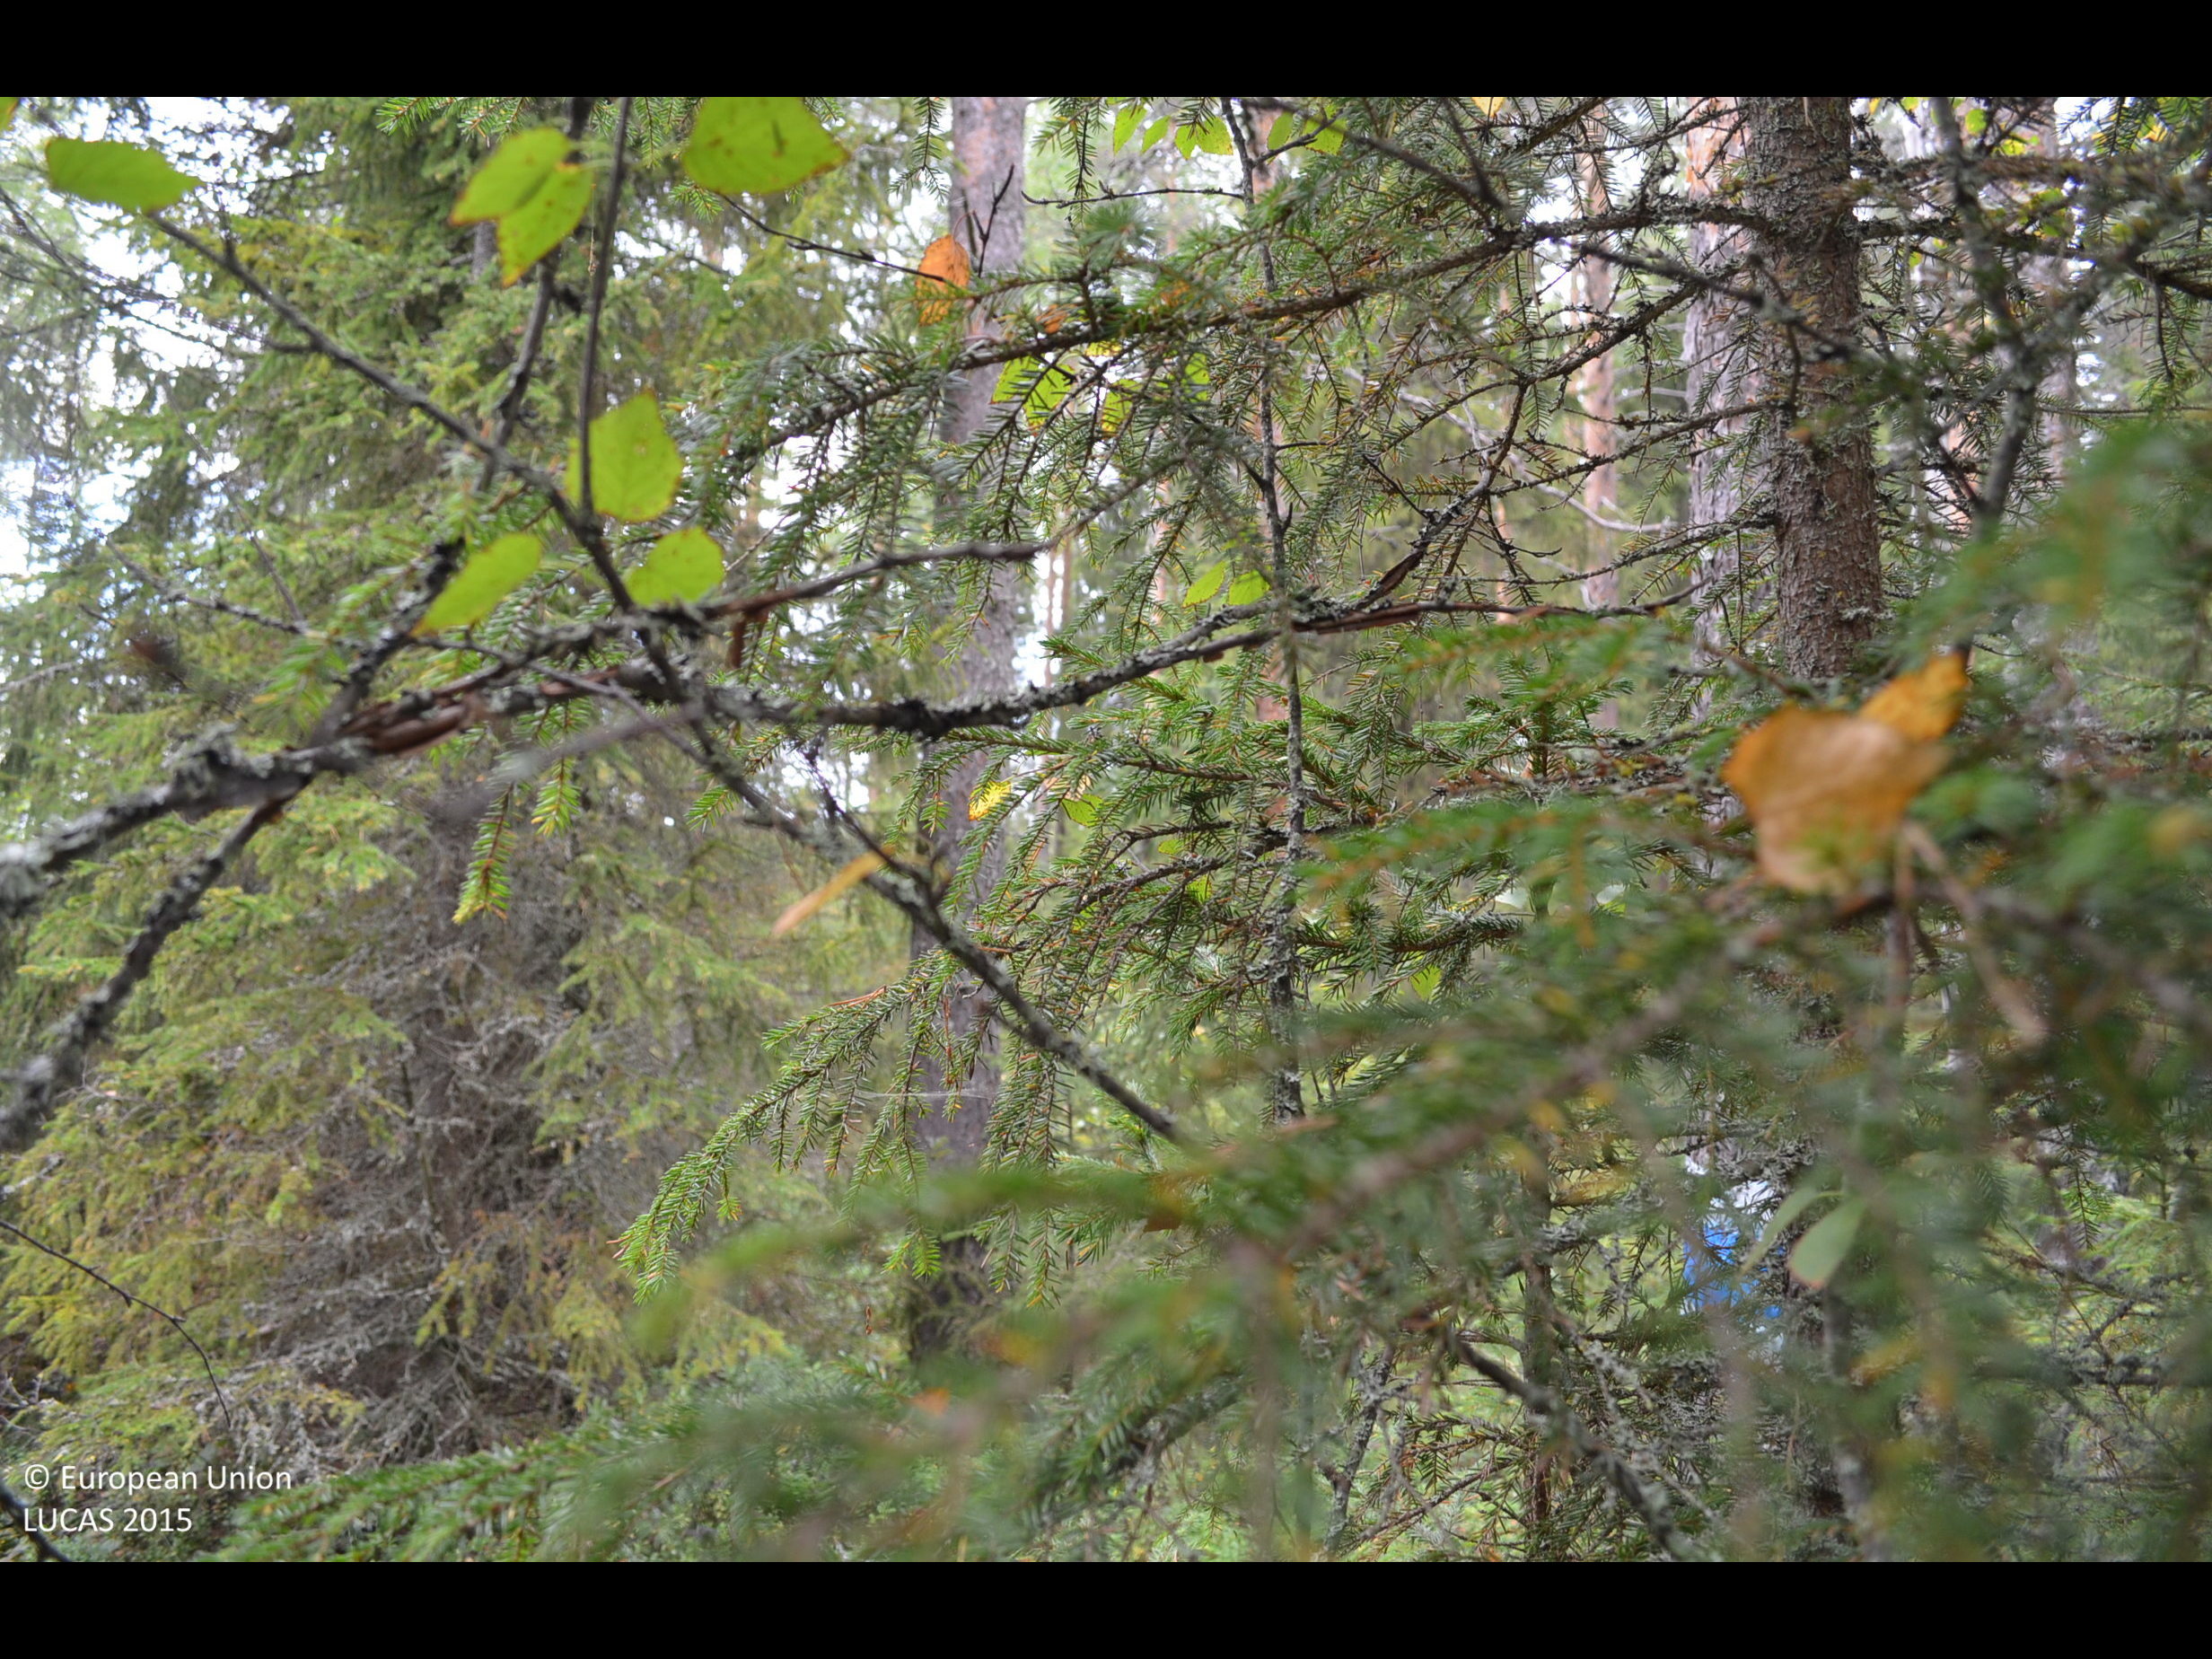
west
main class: Woodland
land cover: Other mixed woodland
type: boreal forest
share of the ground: > 75 %
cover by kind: broadleaved forest trees 40 %, coniferous forest trees 35 %, shrubs 20 %, lichens and mosses 5 %
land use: Forestry
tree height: > 5 m
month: August
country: FI
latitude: 62.6620
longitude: 24.4727
